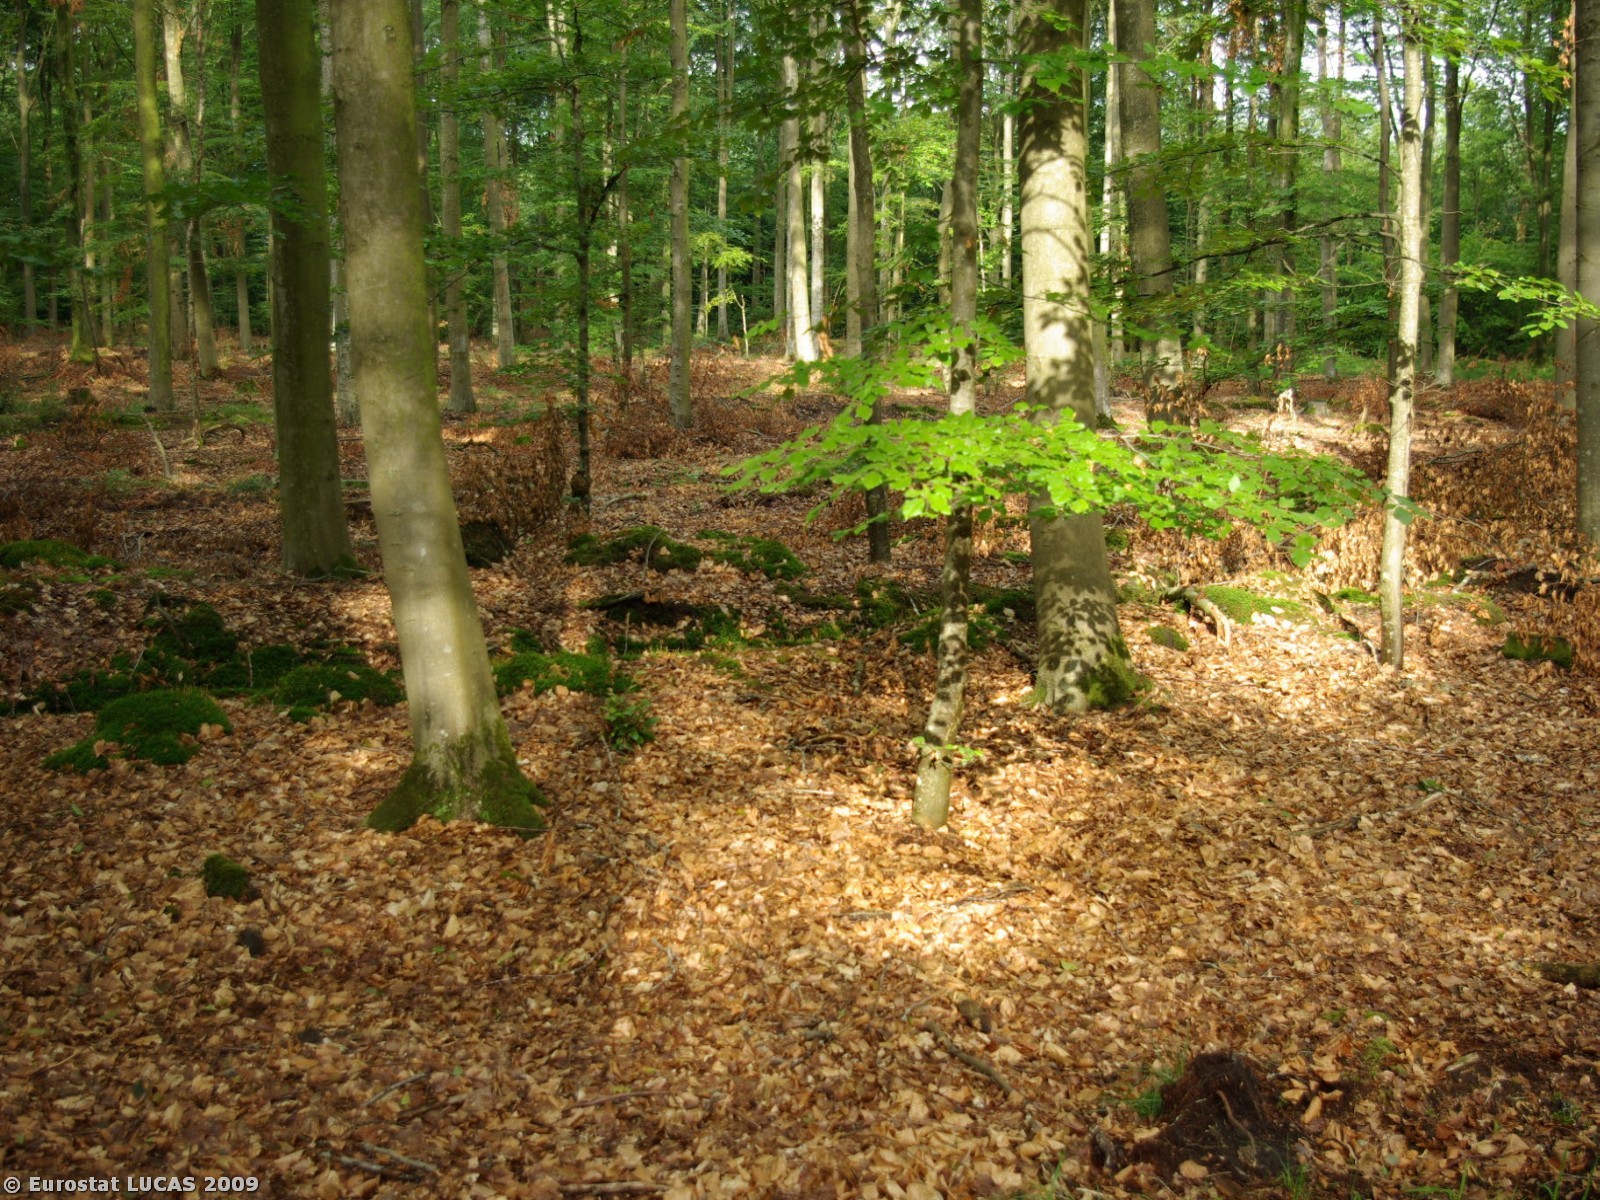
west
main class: Woodland
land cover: Broadleaved woodland
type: beech forest
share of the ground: > 75 %
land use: Forestry
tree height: > 5 m
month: July
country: DK
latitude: 54.9600
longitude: 8.8296
